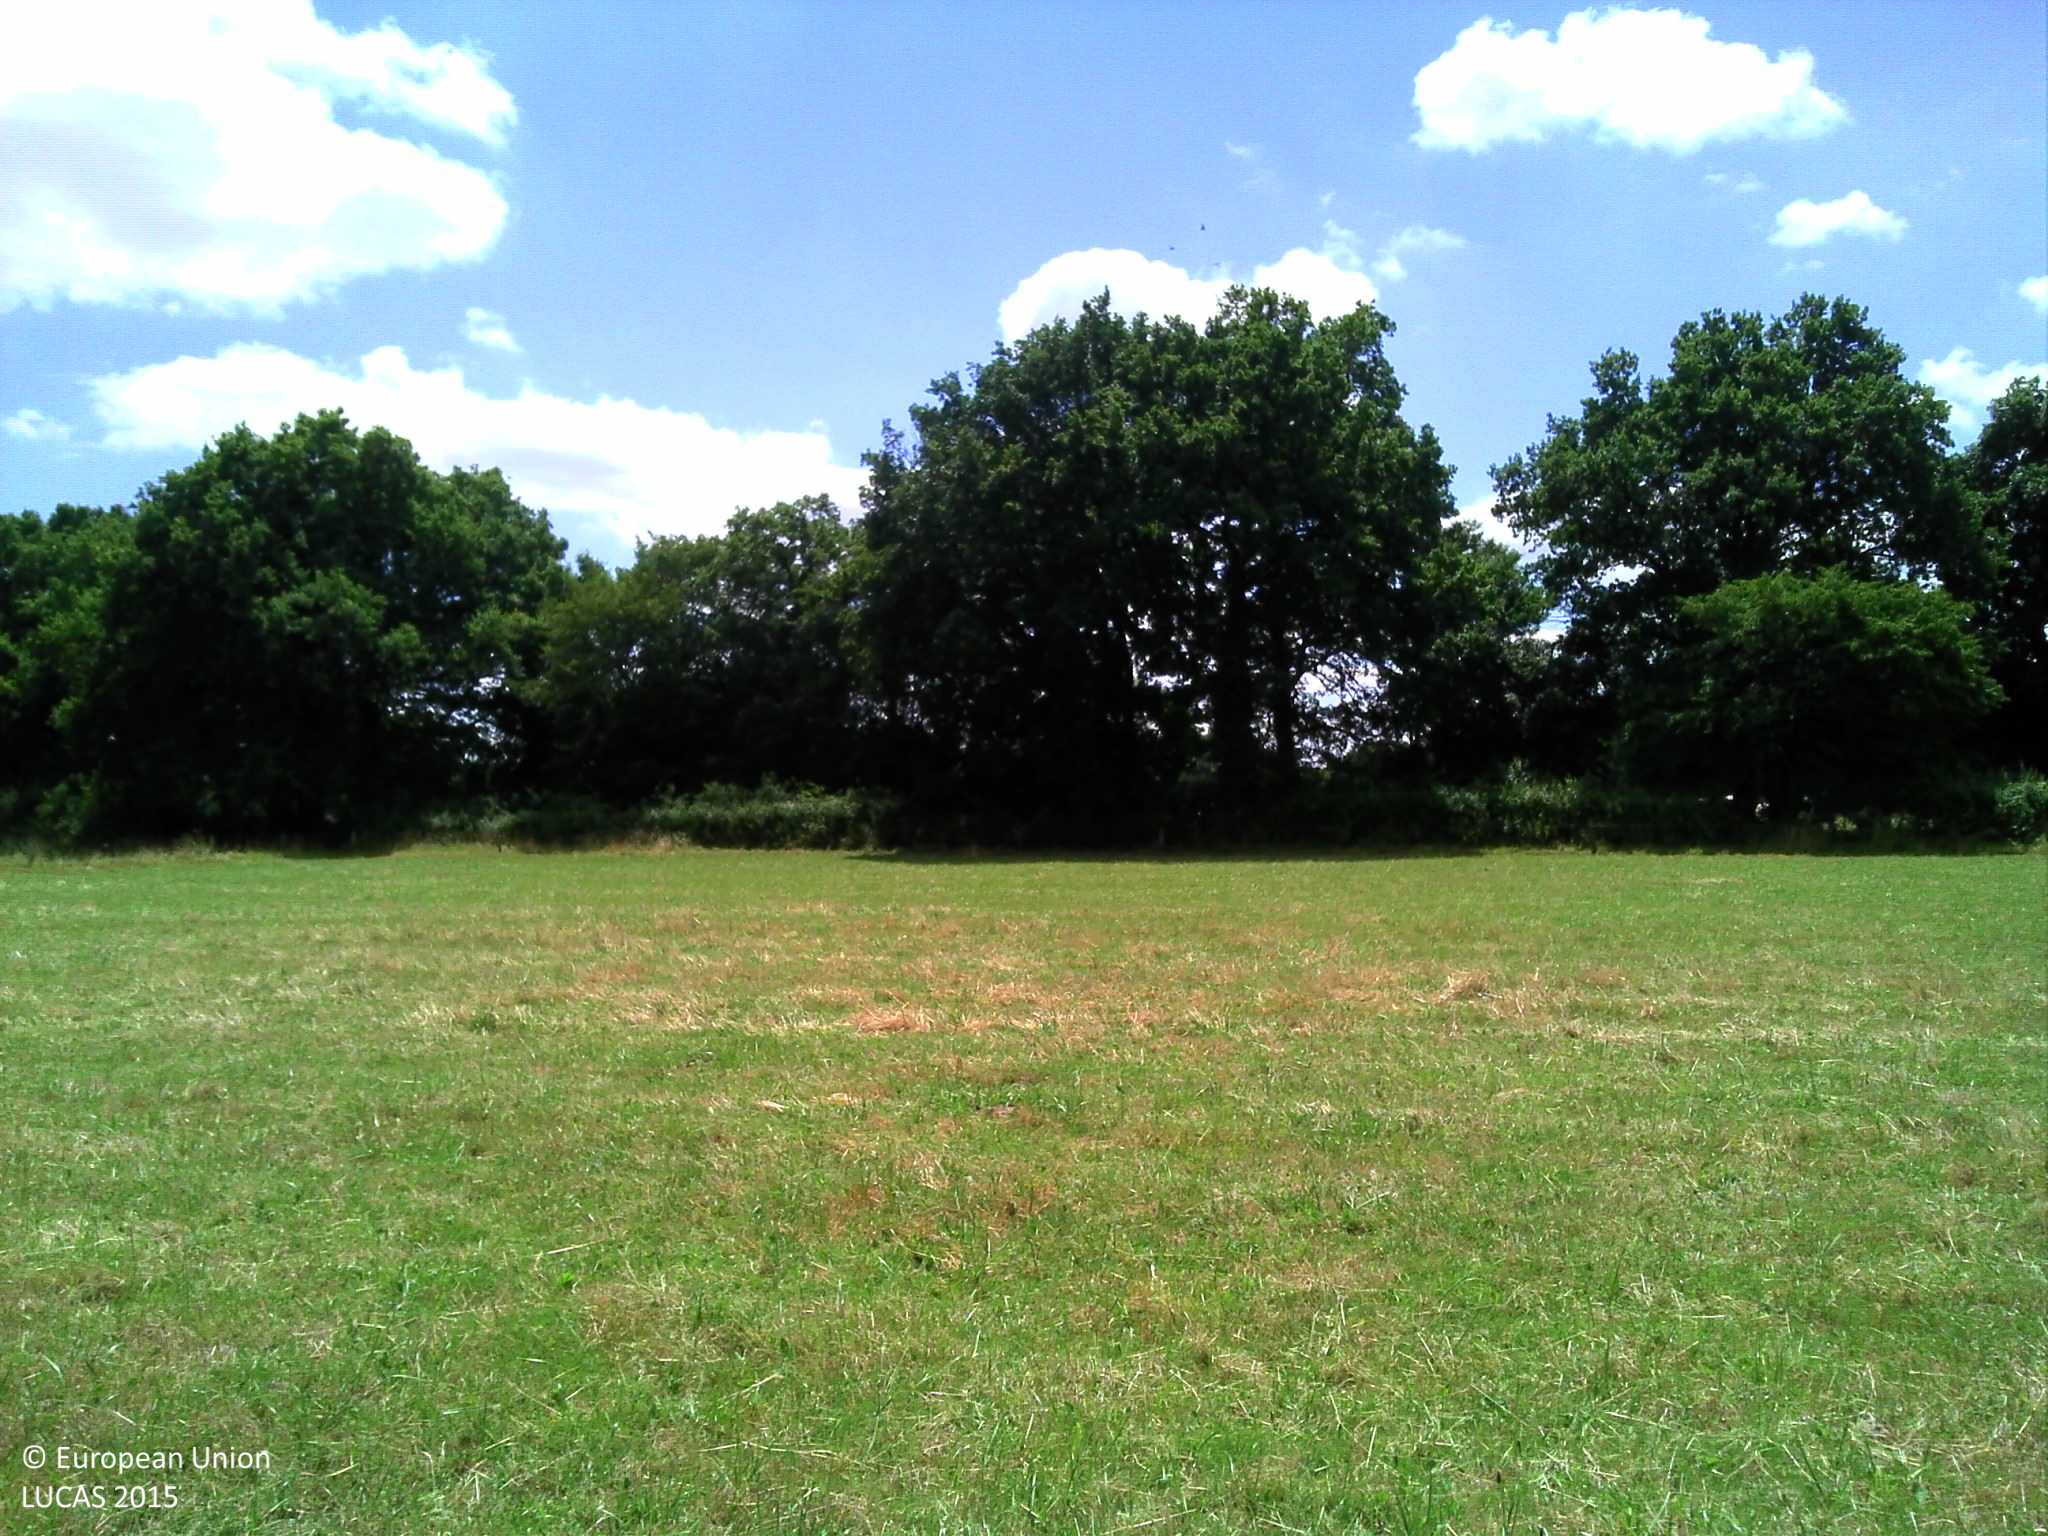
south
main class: Grassland
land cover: Grassland without tree/shrub cover
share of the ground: > 75 %
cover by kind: herbaceous plants 100 %
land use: Agriculture (excluding fallow land and kitchen gardens)
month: June
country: FR
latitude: 46.6509
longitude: 3.6617
